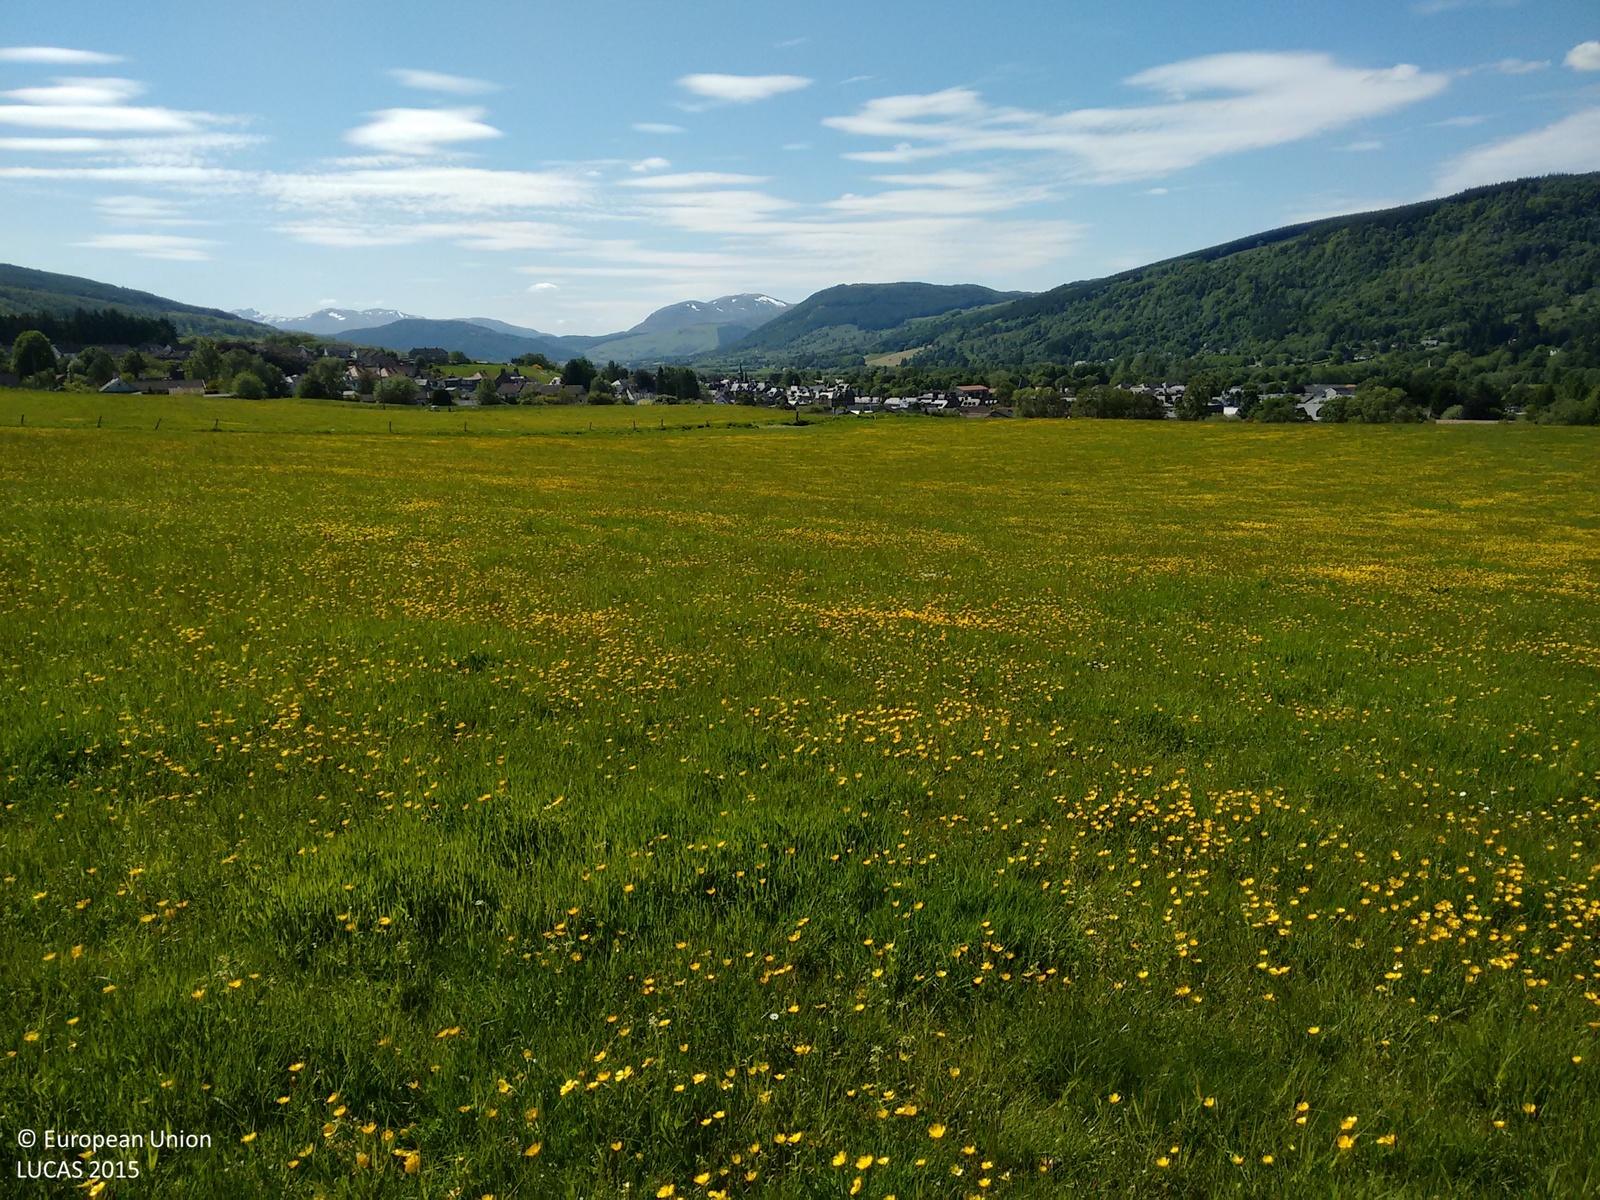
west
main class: Grassland
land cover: Grassland without tree/shrub cover
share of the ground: > 75 %
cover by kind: herbaceous plants 100 %
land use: Agriculture (excluding fallow land and kitchen gardens)
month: June
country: GB
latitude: 56.6195
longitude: -3.8522
